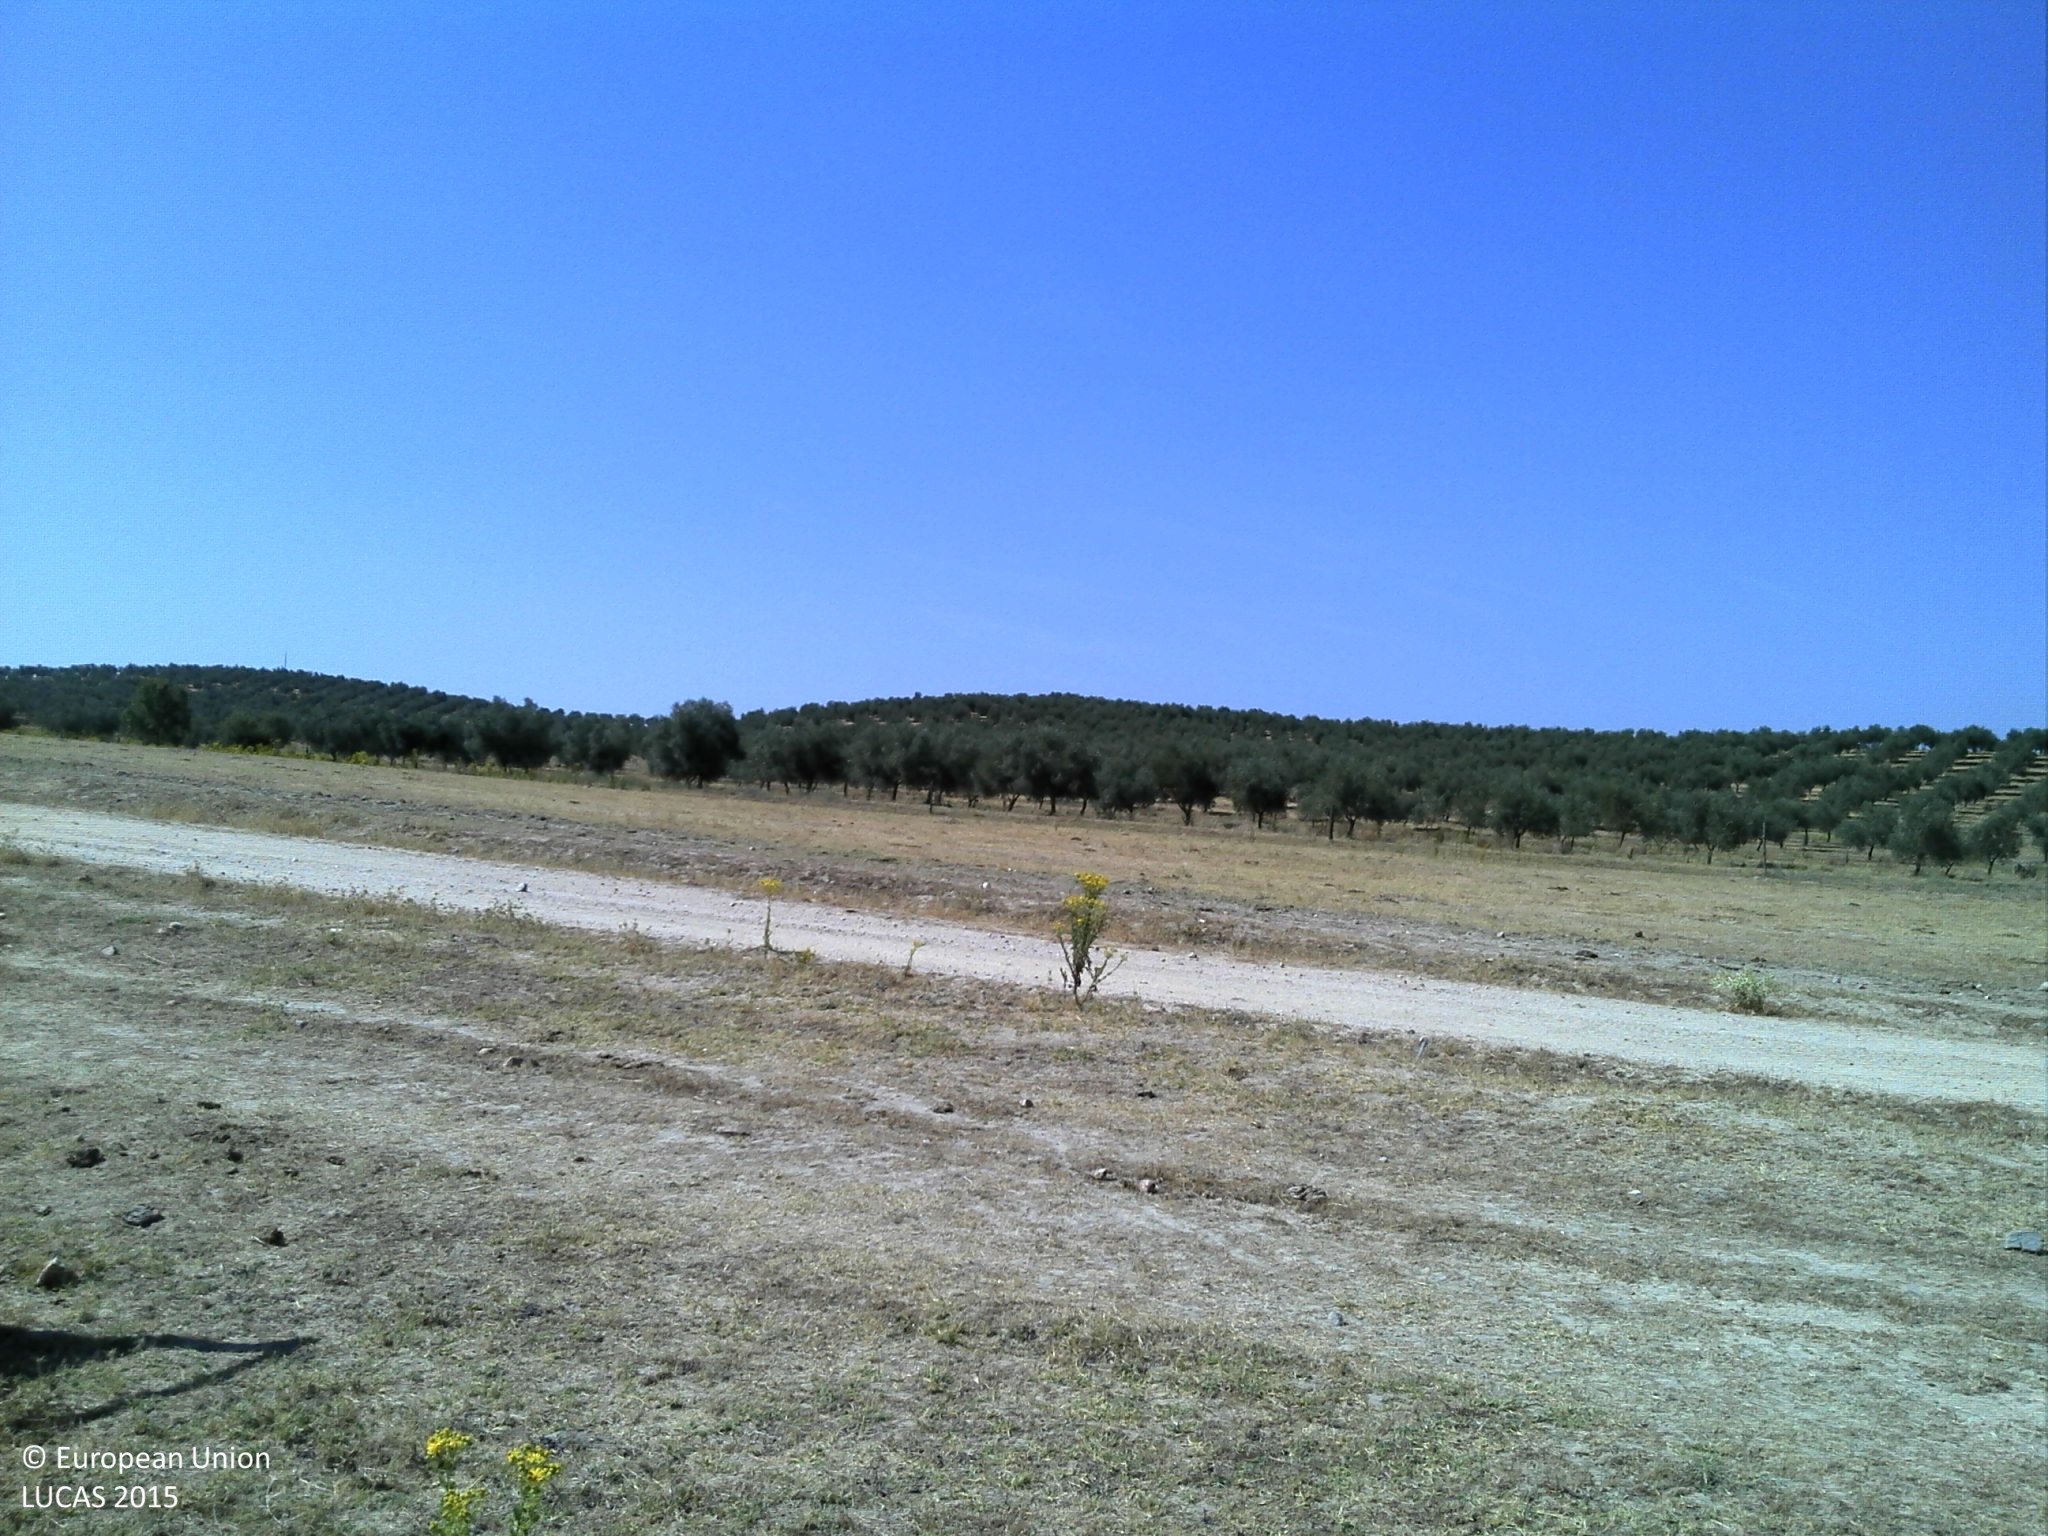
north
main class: Grassland
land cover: Grassland without tree/shrub cover
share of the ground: 25 - 50 %
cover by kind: unconsolidated bare surface 75 %, herbaceous plants 25 %
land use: Agriculture (excluding fallow land and kitchen gardens)
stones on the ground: < 10 %
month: July
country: PT
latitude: 38.5699
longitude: -7.6983
